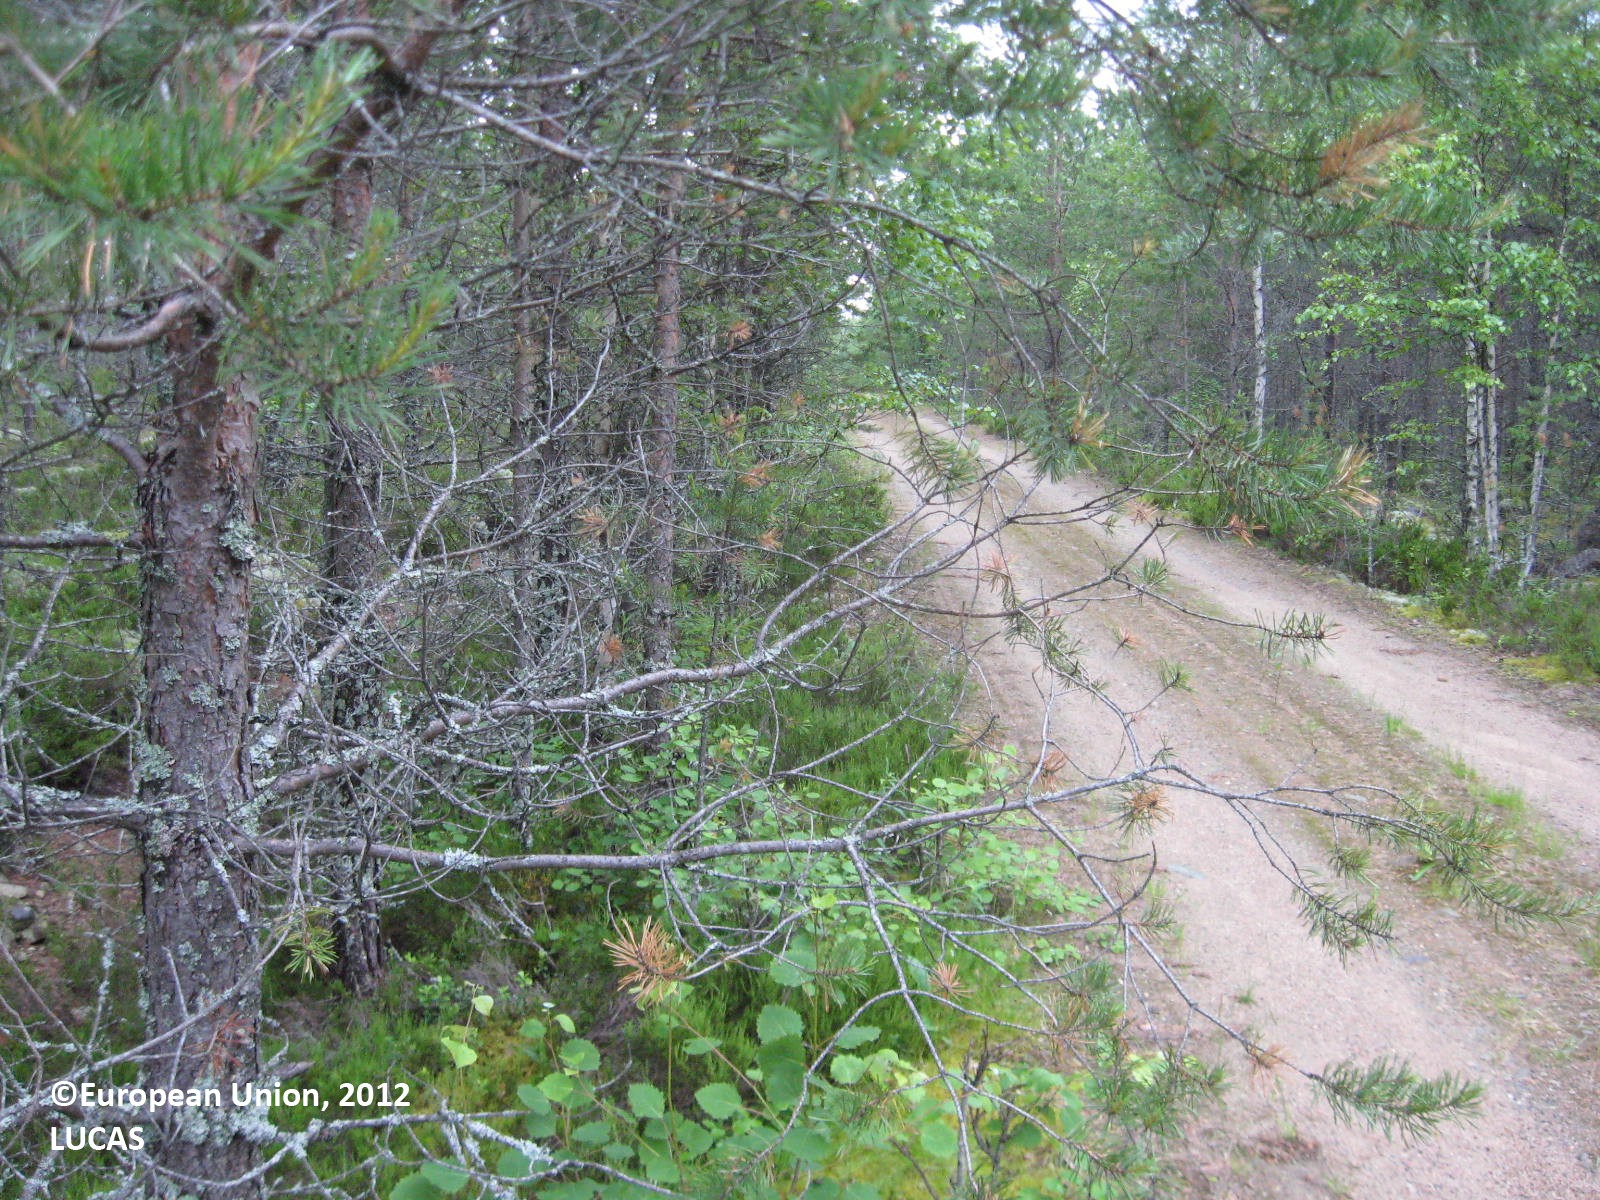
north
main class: Woodland
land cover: Pine dominated coniferous woodland
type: boreal forest
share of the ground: > 75 %
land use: Forestry
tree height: > 5 m
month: July
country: FI
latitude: 62.3473
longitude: 22.4755
